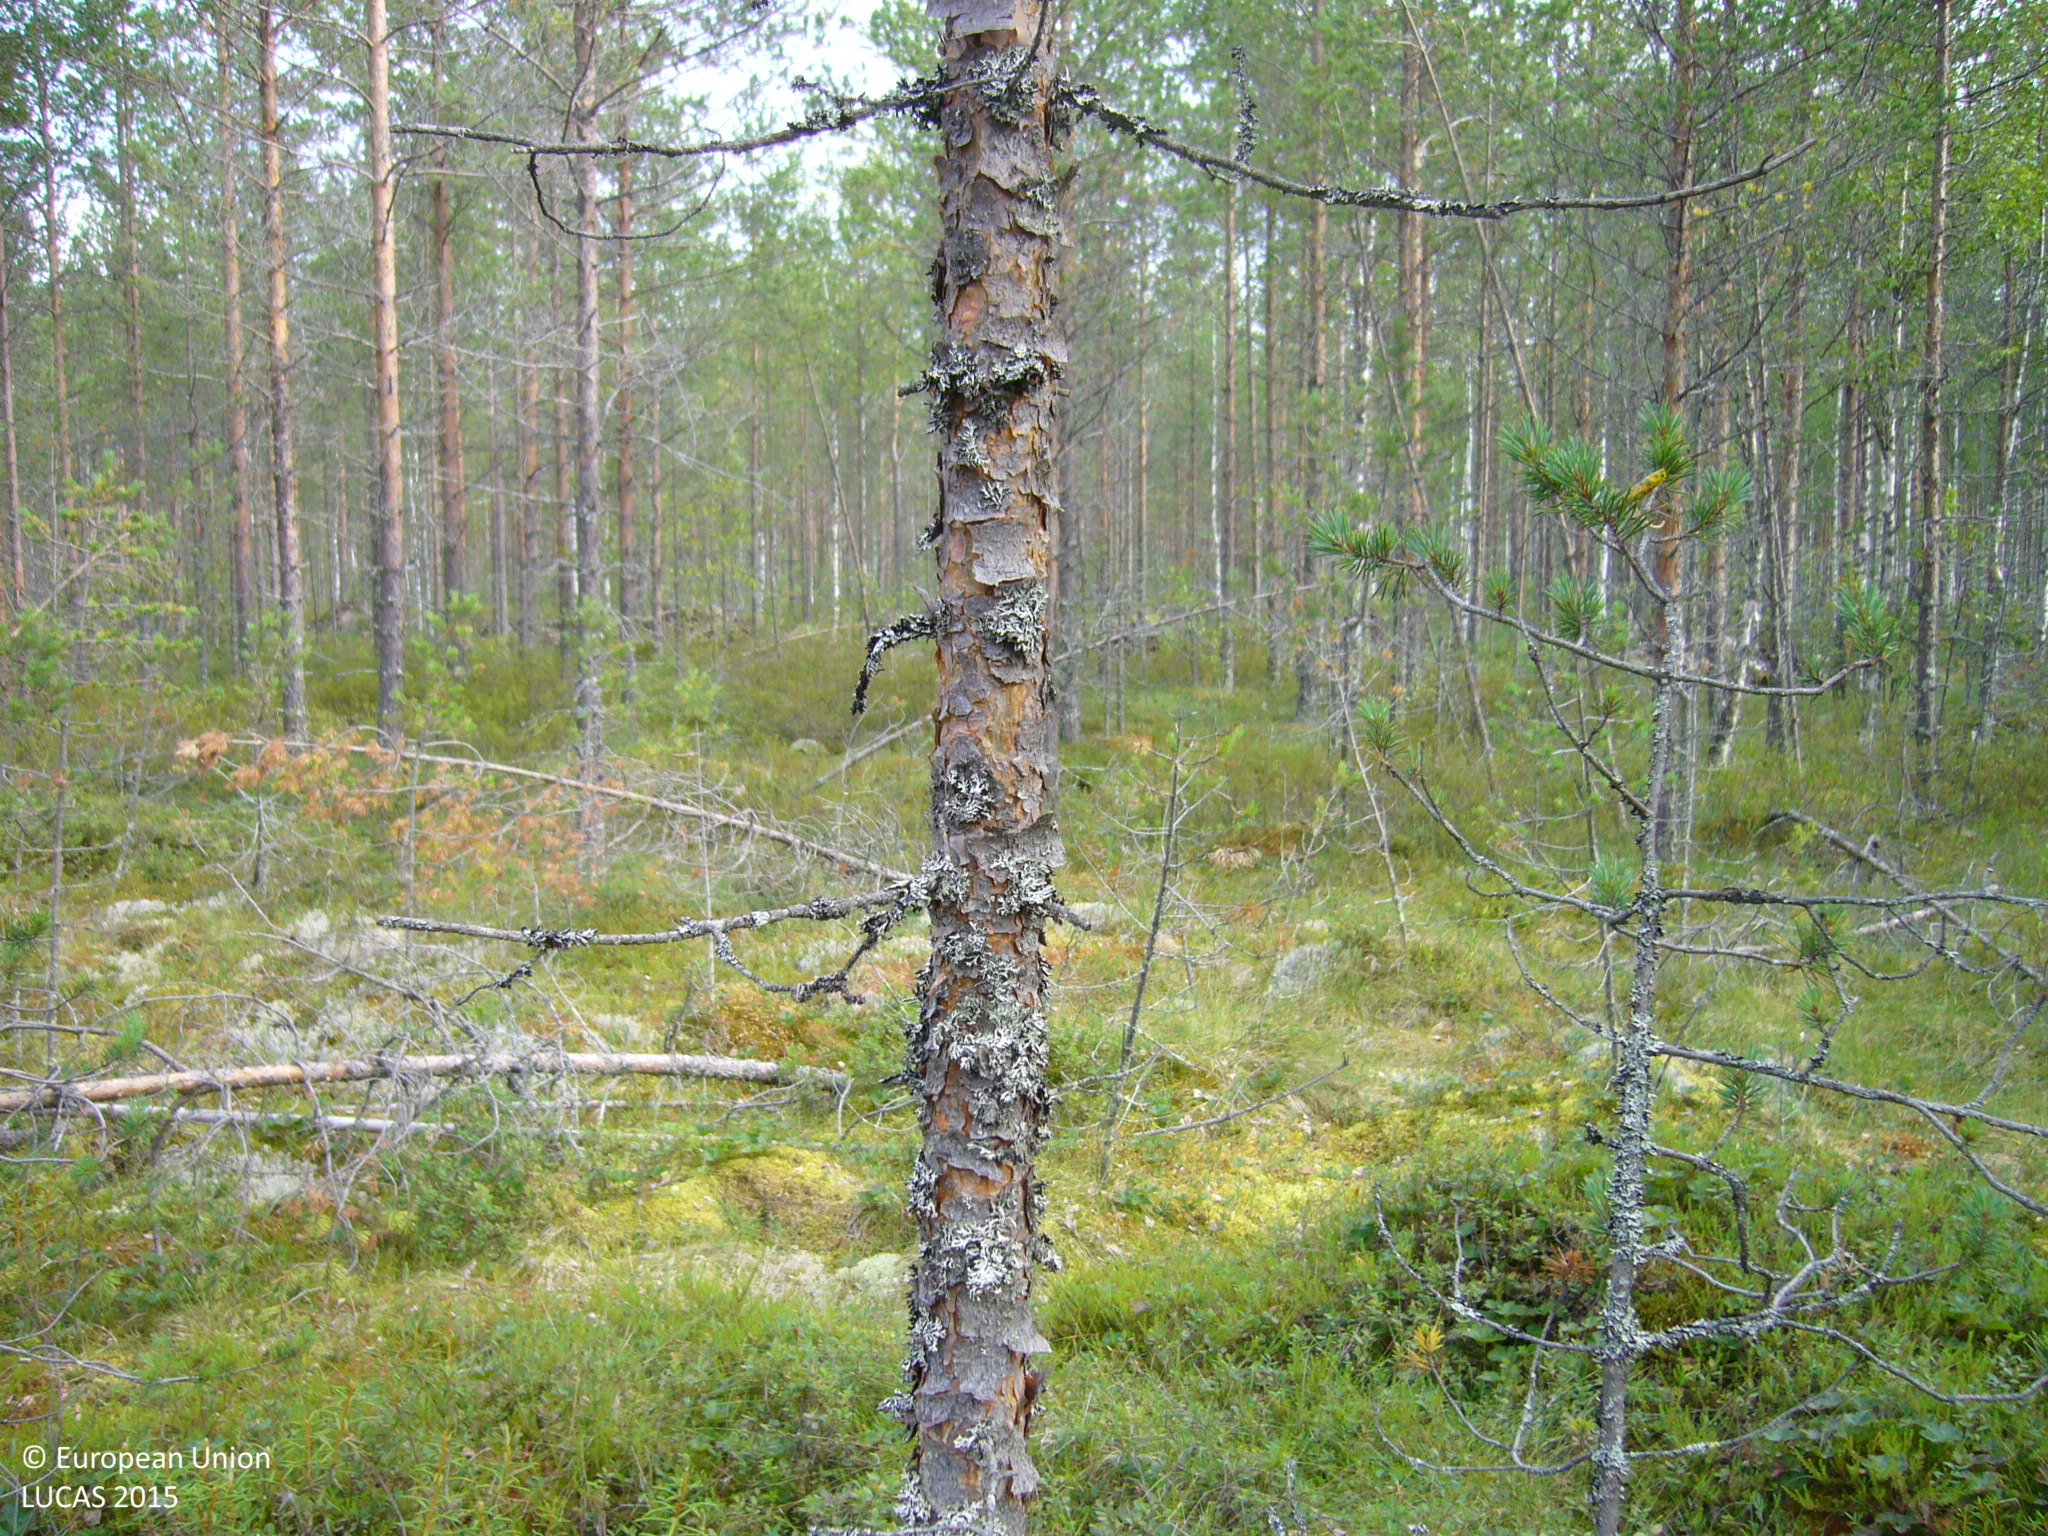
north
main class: Woodland
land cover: Pine dominated mixed woodland
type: boreal forest
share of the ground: 50 - 75 %
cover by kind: coniferous forest trees 40 %, shrubs 35 %, broadleaved forest trees 25 %
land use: Forestry
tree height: > 5 m
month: July
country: FI
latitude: 64.1000
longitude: 25.9671
